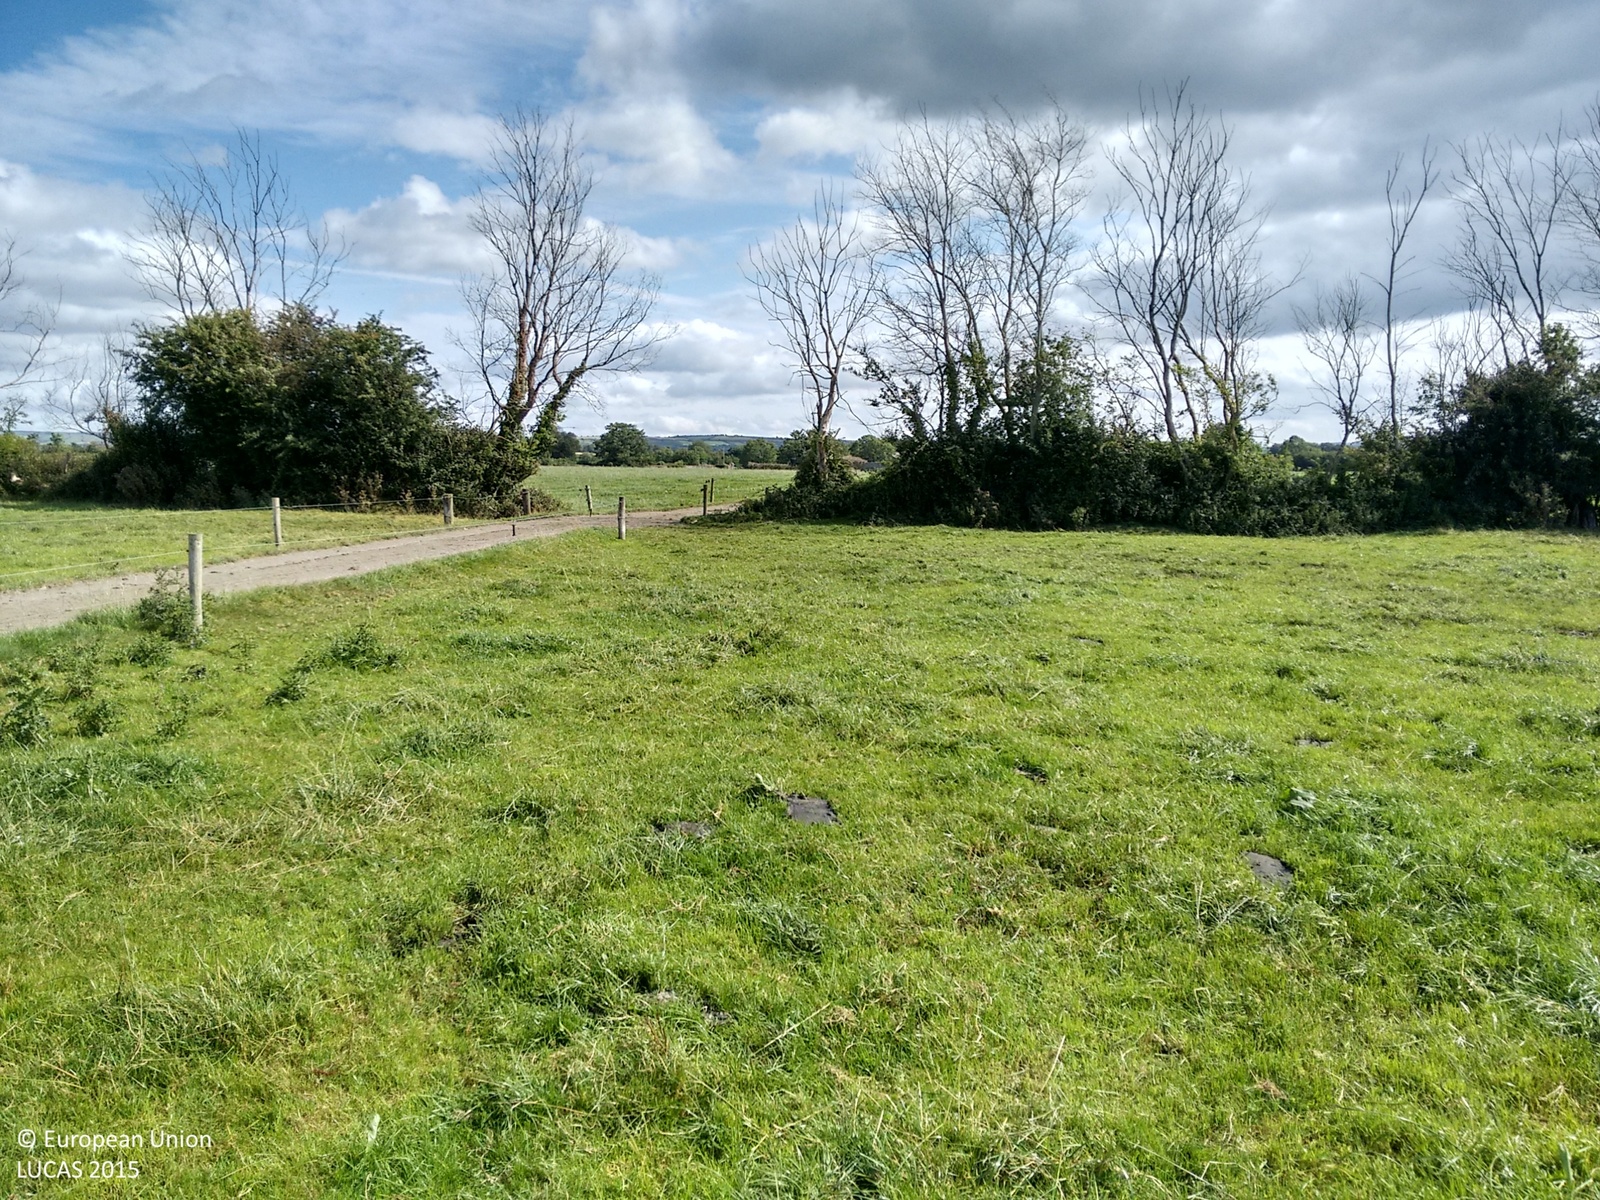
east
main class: Grassland
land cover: Grassland without tree/shrub cover
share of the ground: > 75 %
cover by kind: herbaceous plants 100 %
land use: Agriculture (excluding fallow land and kitchen gardens)
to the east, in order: Grassland without tree/shrub cover; Abandoned hedges; Ditches and canals; Grassland without tree/shrub cover; Fences; Tracks; Fences; Grassland without tree/shrub cover
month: August
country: IE
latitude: 52.7558
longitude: -7.3873
